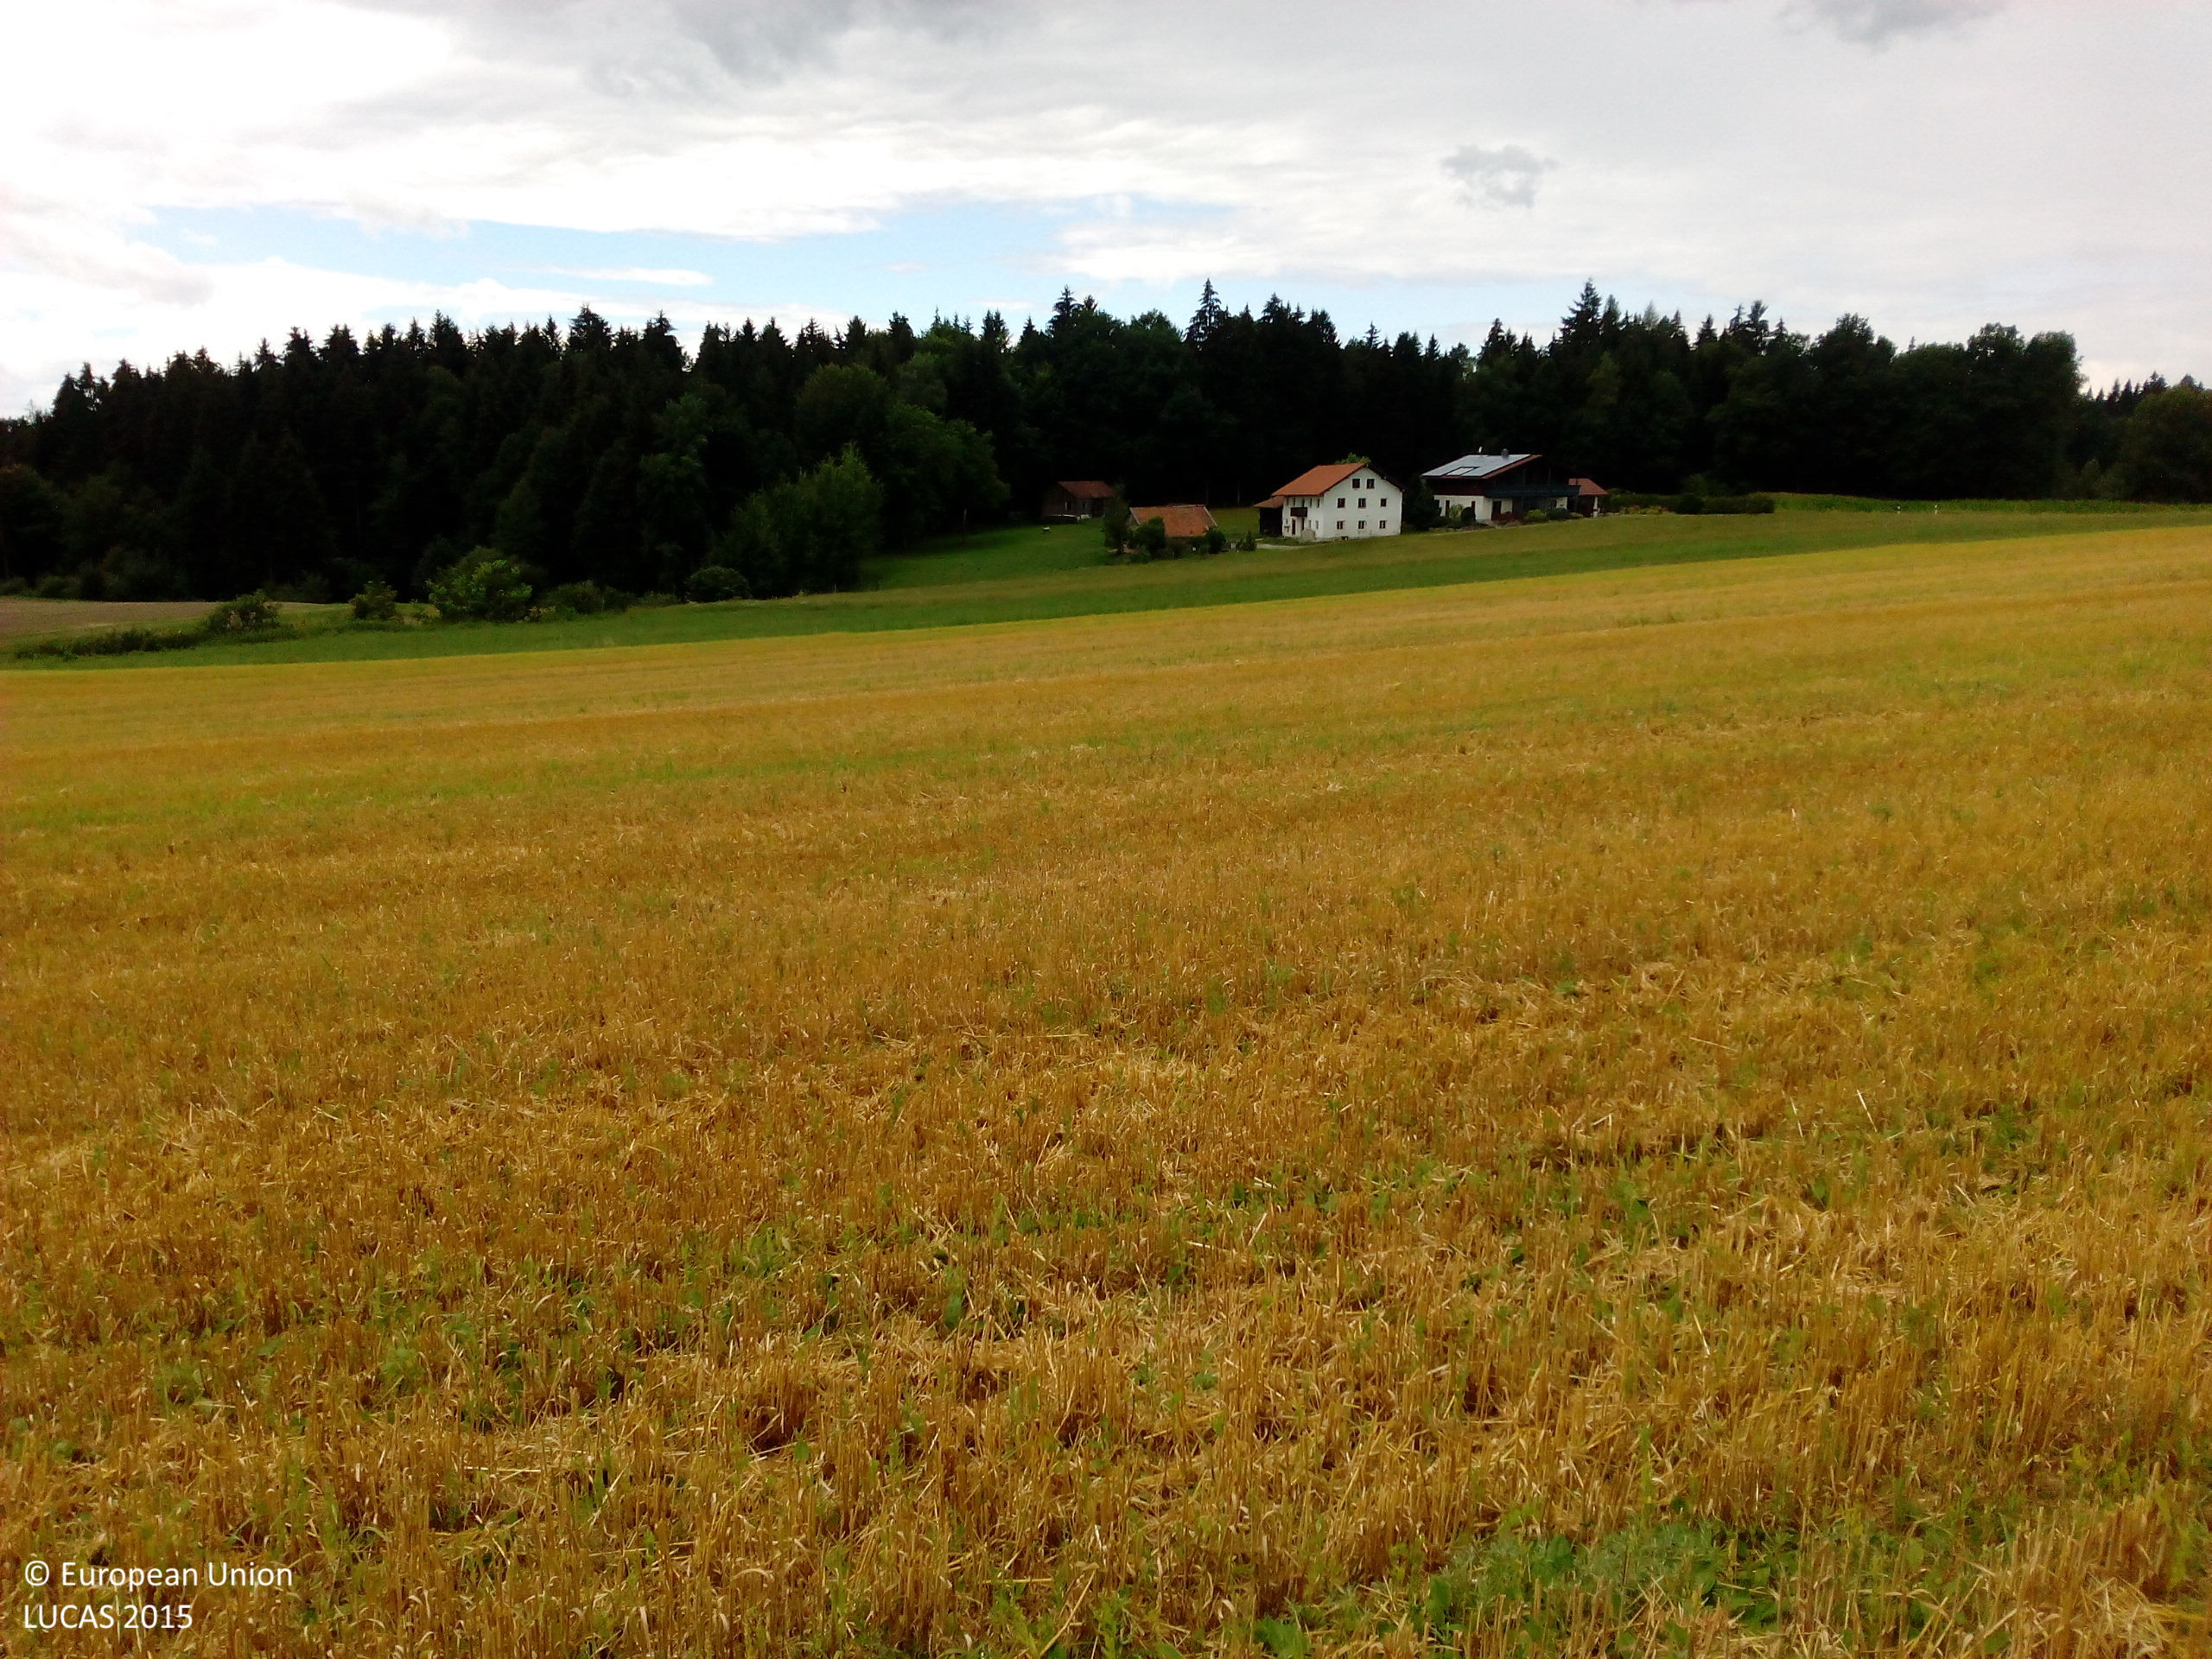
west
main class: Cropland
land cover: Maize
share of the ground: > 75 %
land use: Agriculture (excluding fallow land and kitchen gardens)
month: July
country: DE
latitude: 48.8688
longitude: 12.9306
